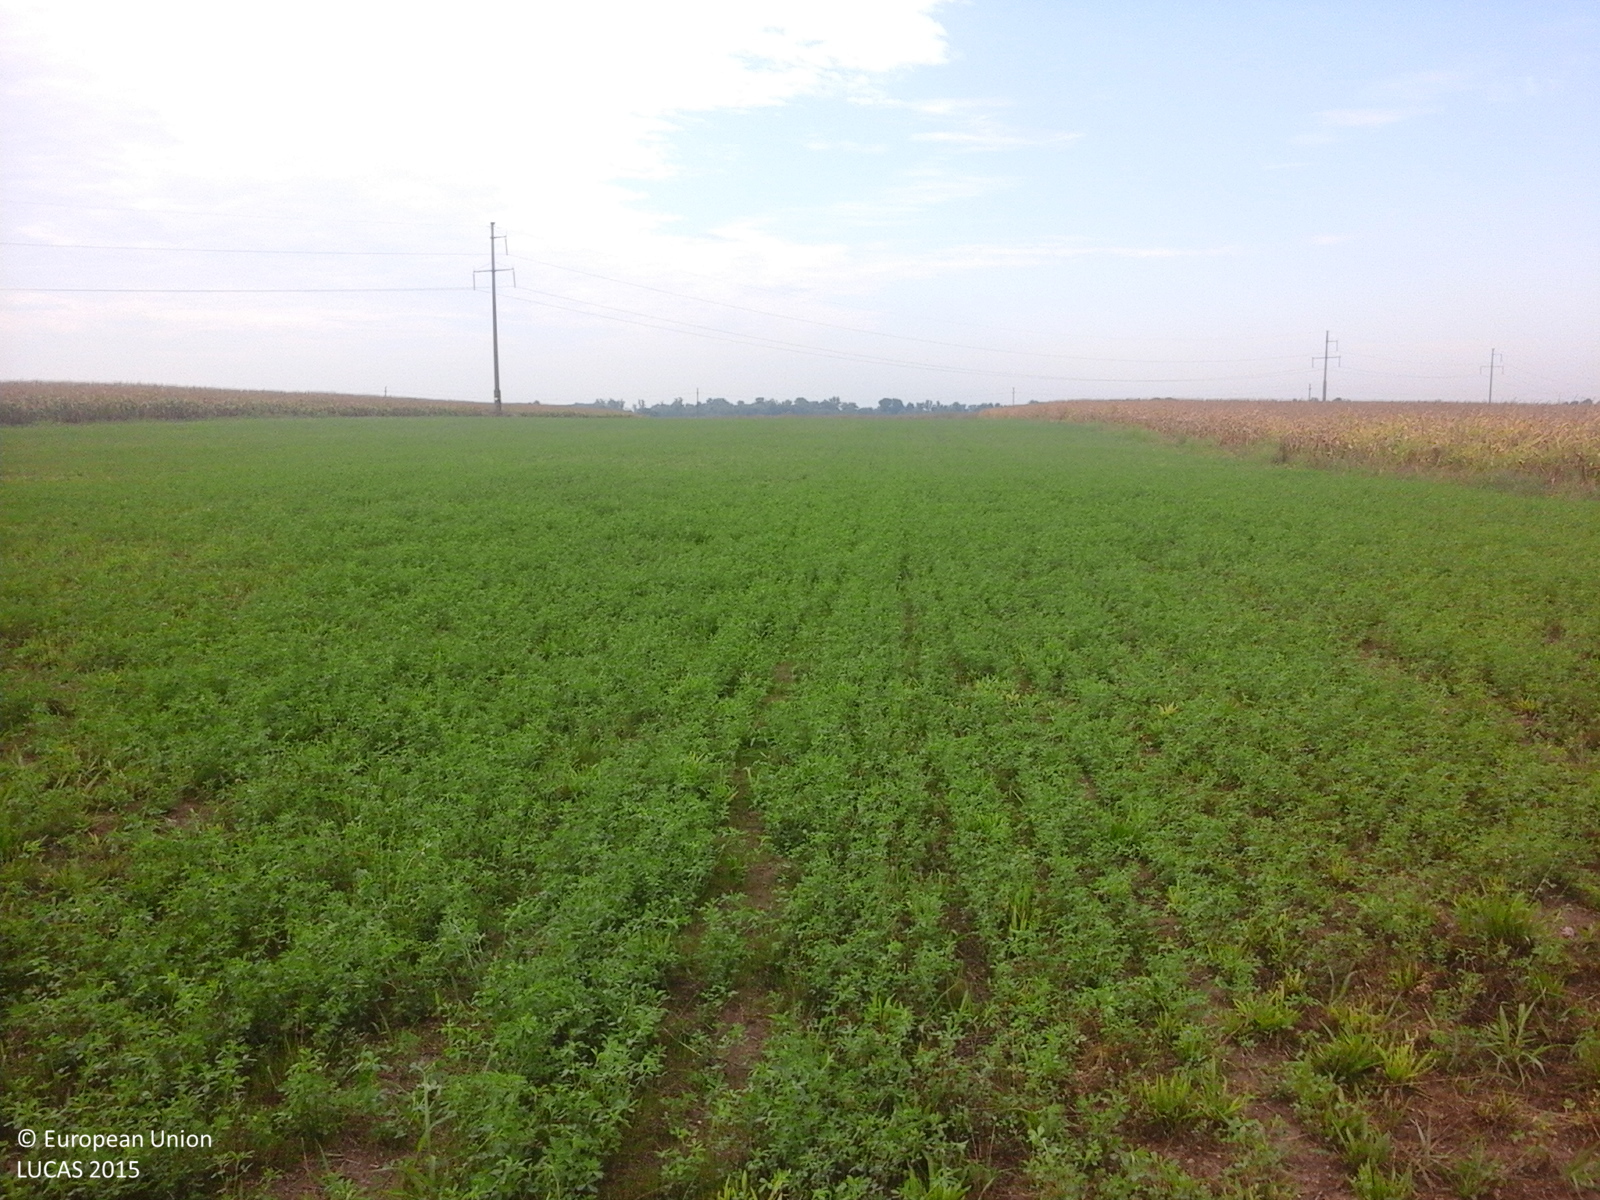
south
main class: Cropland
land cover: Lucerne
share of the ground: > 75 %
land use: Agriculture (excluding fallow land and kitchen gardens)
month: August
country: RO
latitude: 46.1057
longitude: 20.8567
